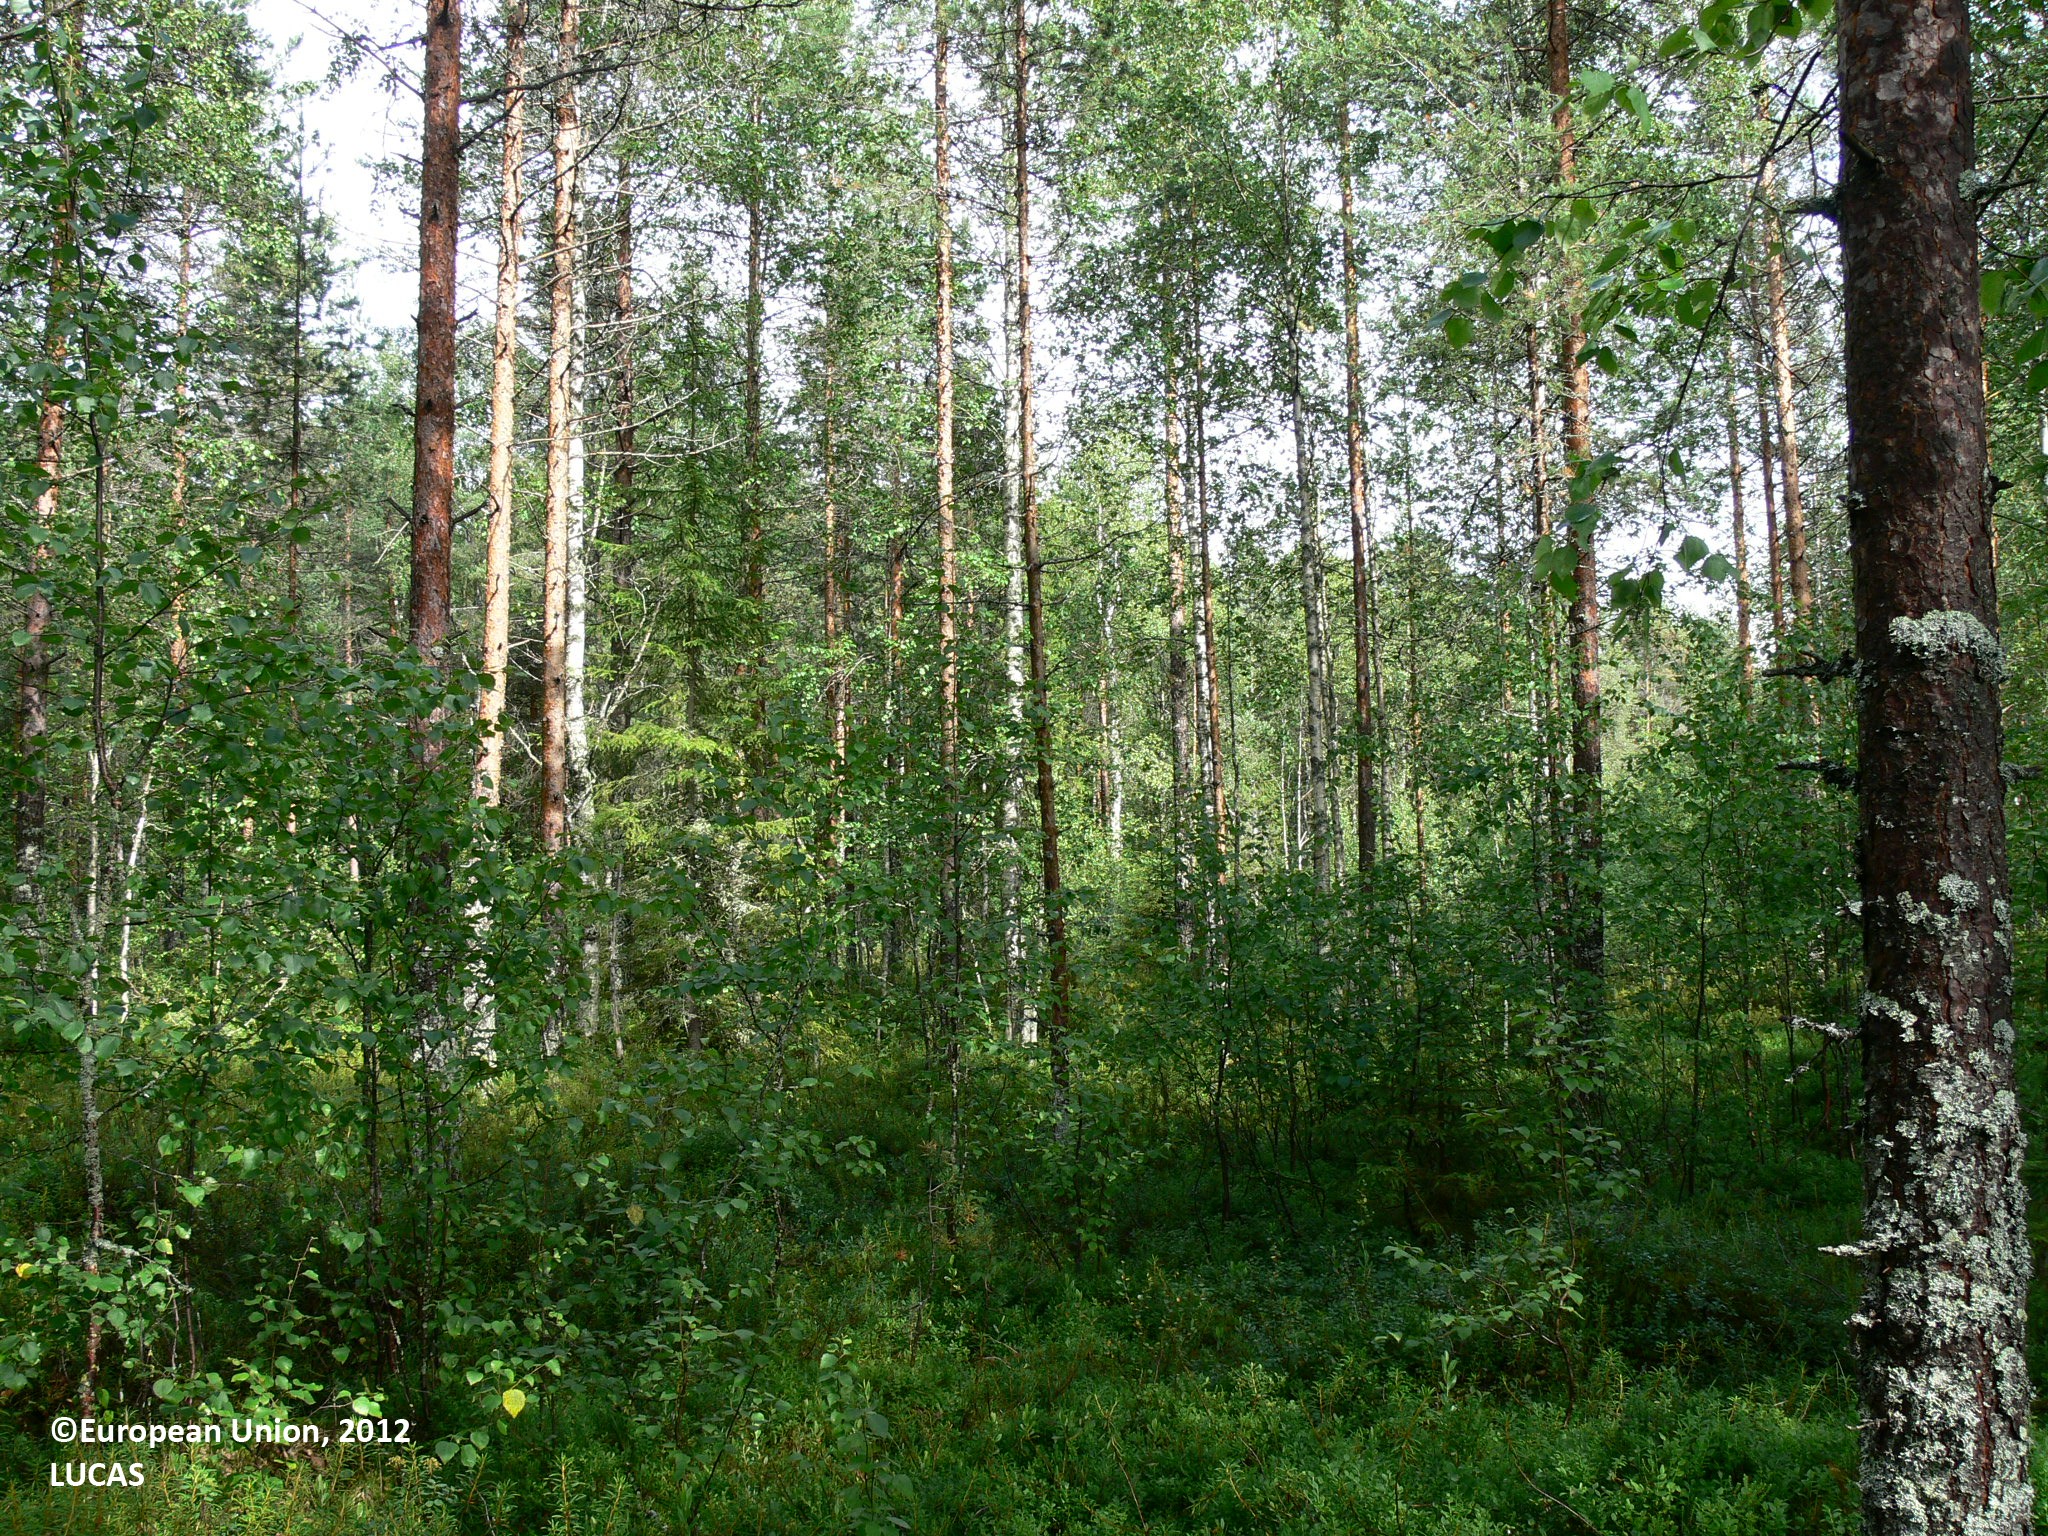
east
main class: Woodland
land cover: Pine dominated mixed woodland
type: boreal forest
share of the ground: 50 - 75 %
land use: Forestry
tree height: > 5 m
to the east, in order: Pine dominated mixed woodland; Ditches and canals; Other mixed woodland; Ditches and canals; Other mixed woodland; Ditches and canals; Other coniferous woodland; Pine dominated coniferous woodland
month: July
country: FI
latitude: 63.0602
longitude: 29.3174
